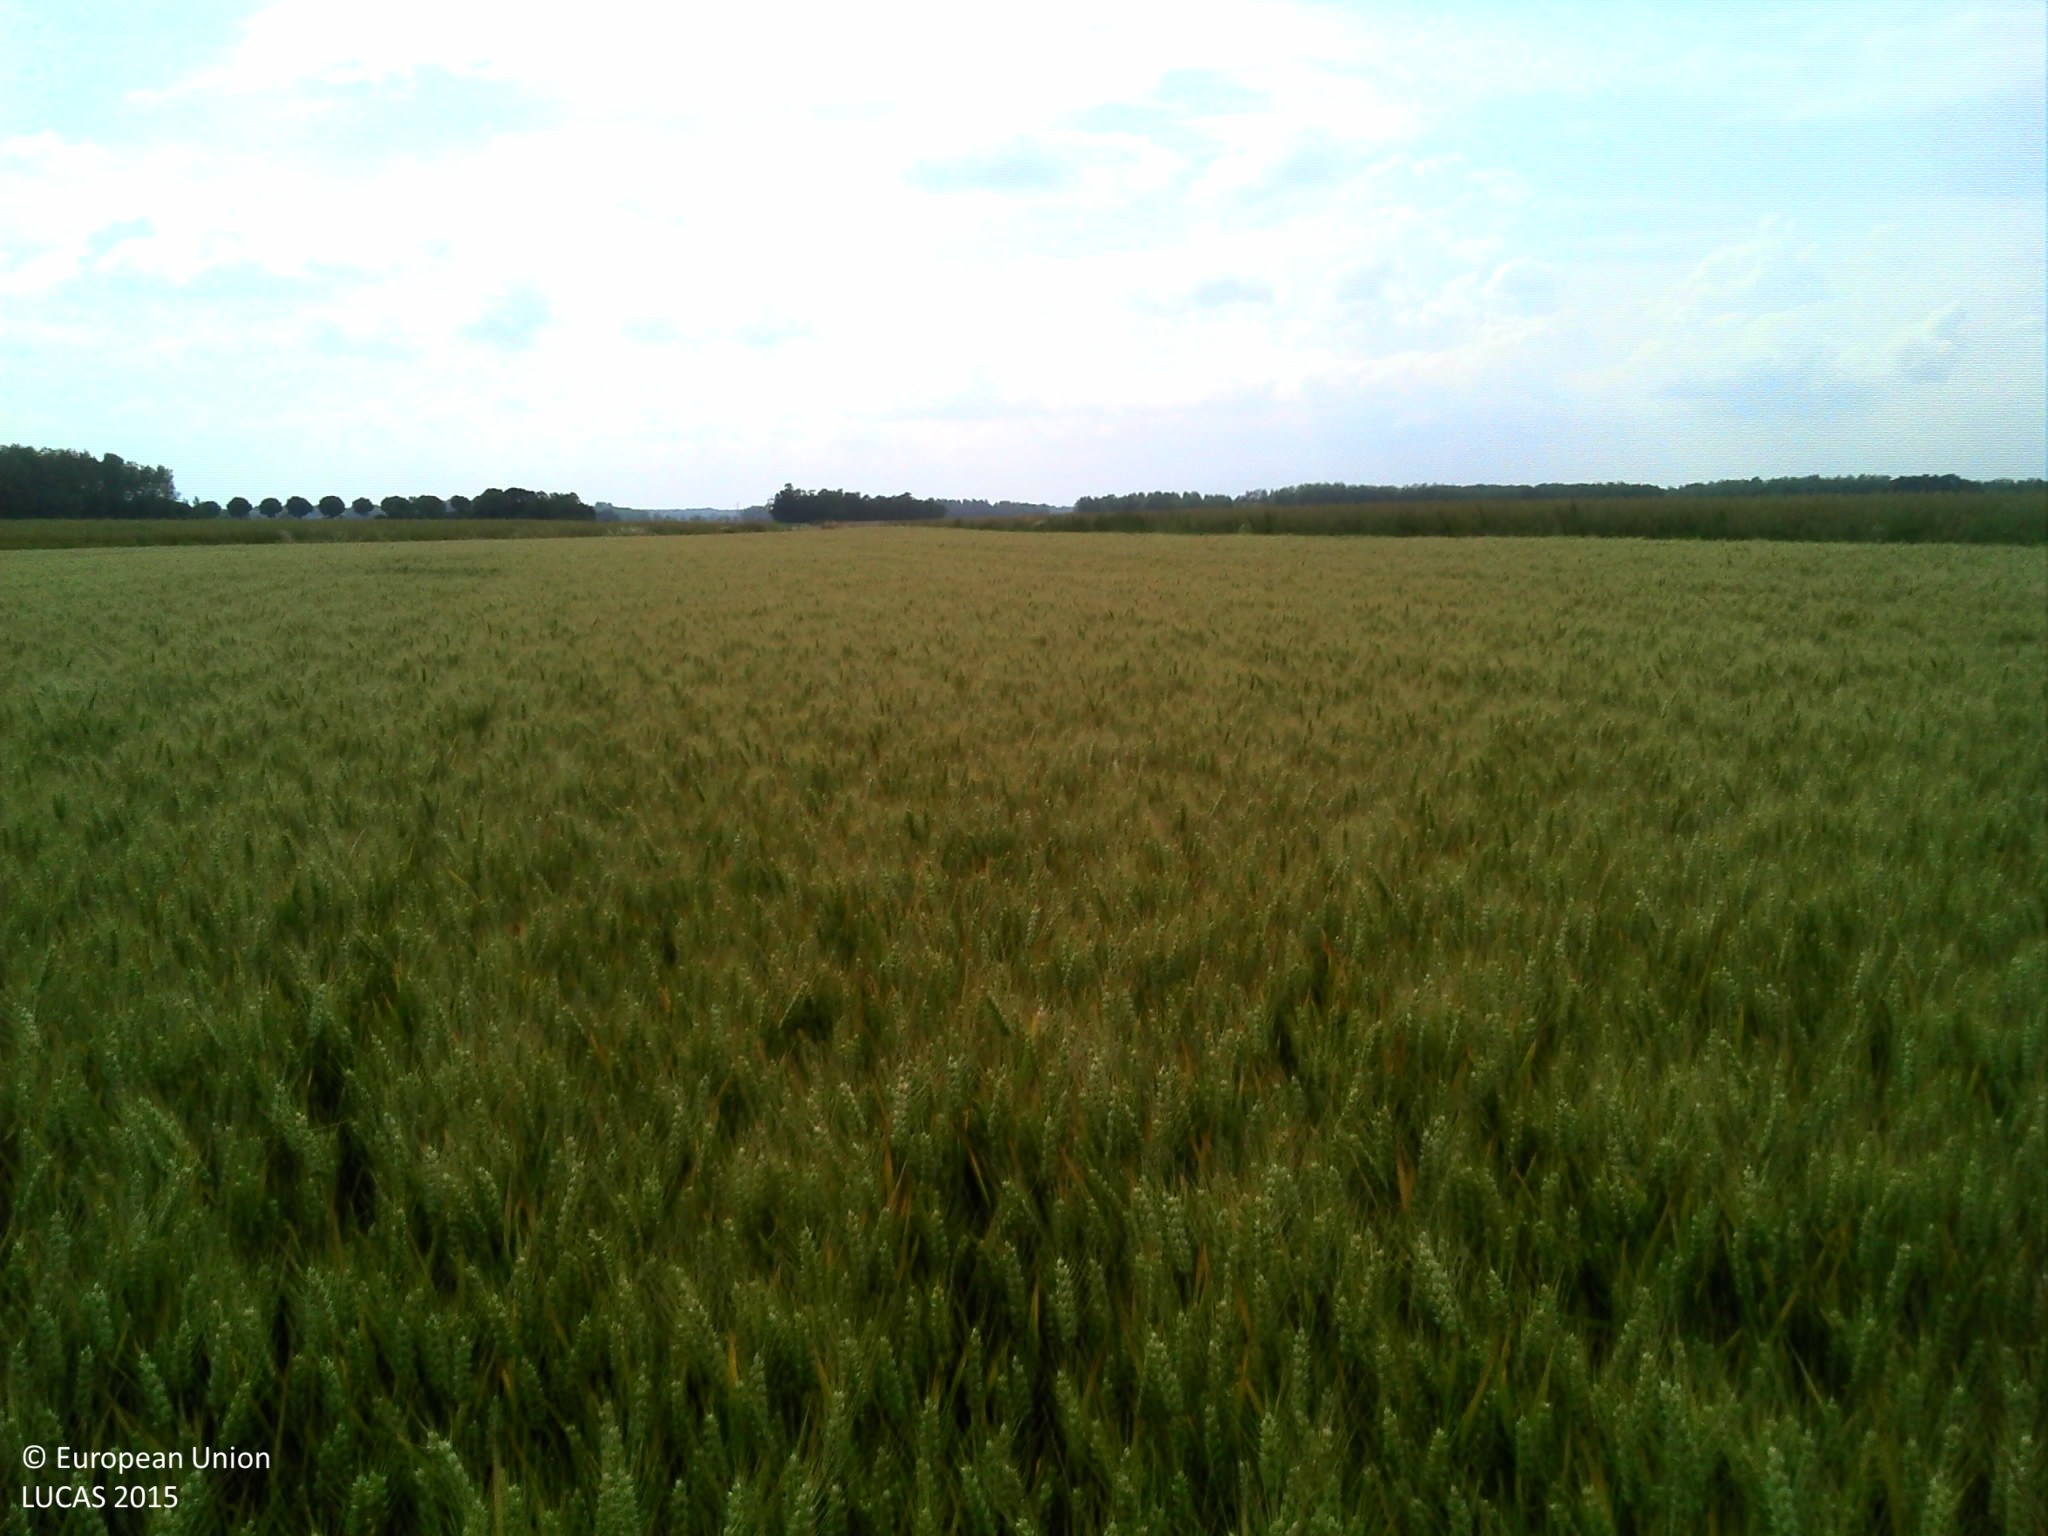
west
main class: Cropland
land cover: Common wheat
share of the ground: > 75 %
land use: Agriculture (excluding fallow land and kitchen gardens)
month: June
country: FR
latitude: 47.0237
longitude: 5.3044
